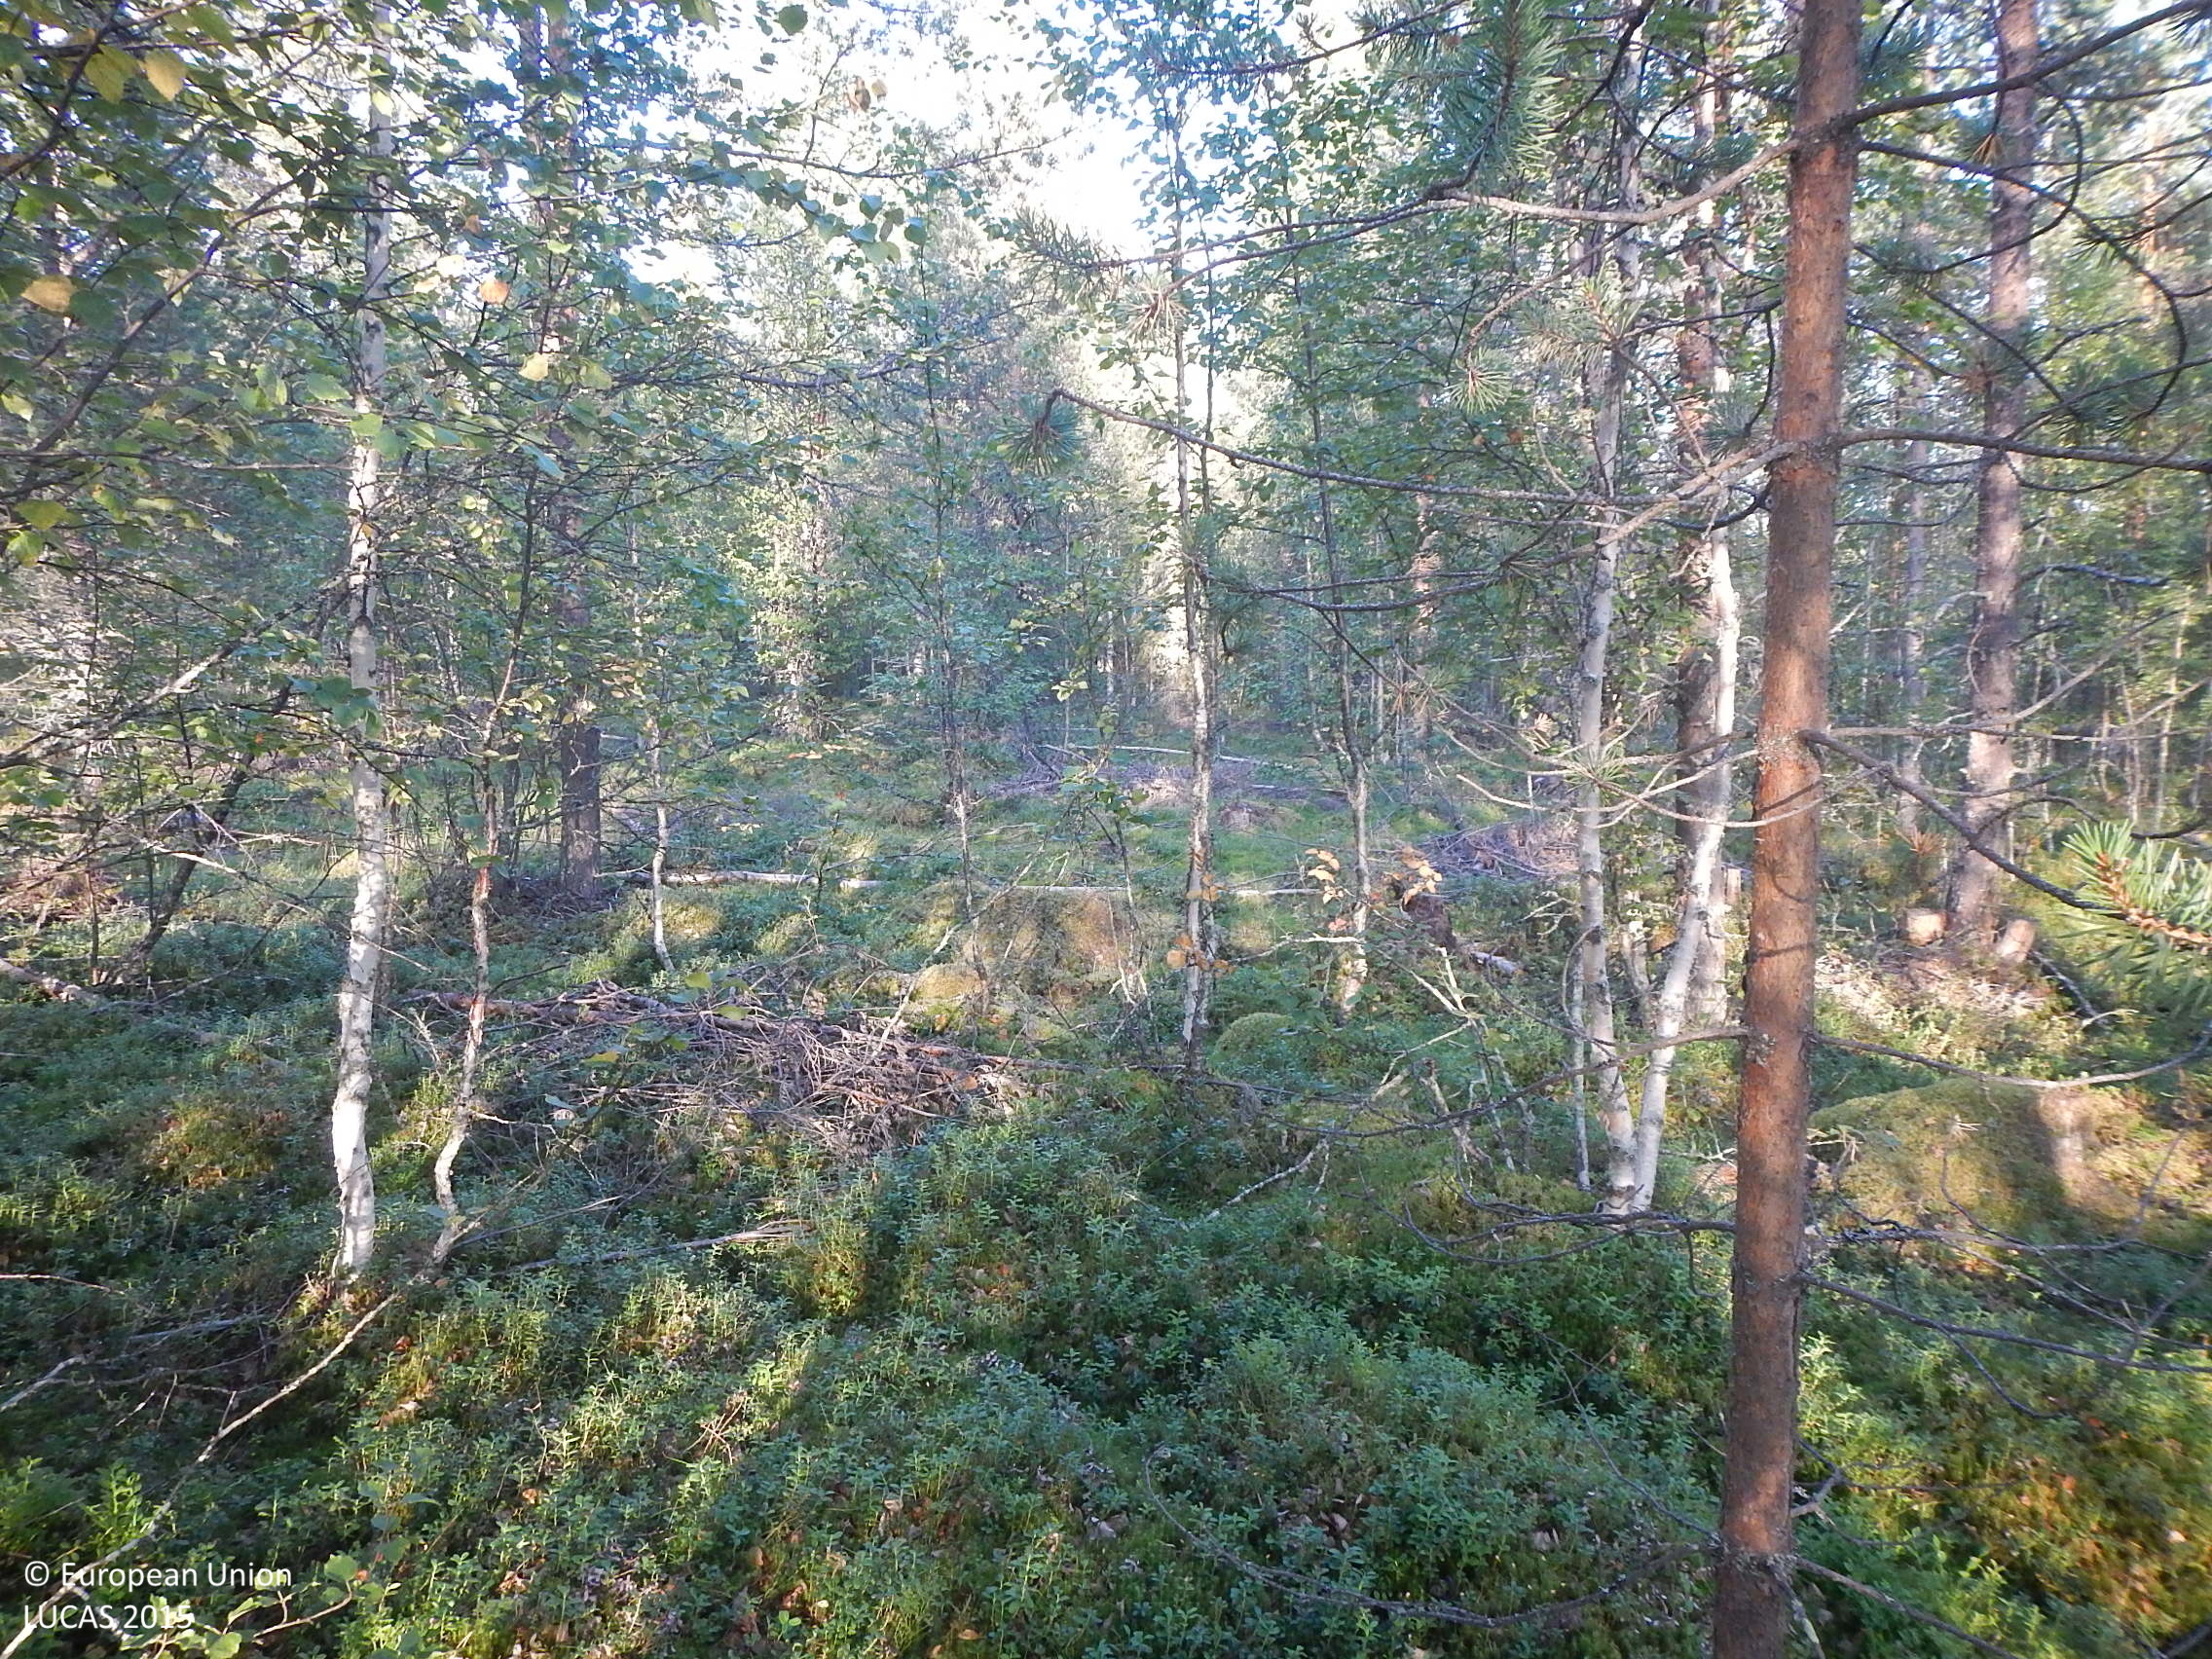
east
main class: Woodland
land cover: Pine dominated mixed woodland
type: boreal forest
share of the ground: > 75 %
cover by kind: coniferous forest trees 50 %, broadleaved forest trees 30 %, shrubs 10 %, lichens and mosses 10 %
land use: Forestry
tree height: > 5 m
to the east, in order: Pine dominated mixed woodland; Tracks; Pine dominated mixed woodland; Ditches and canals; Pine dominated mixed woodland; Pine dominated coniferous woodland; Ditches and canals; Fences; Other mixed woodland; Other coniferous woodland
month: August
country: FI
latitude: 66.4516
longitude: 28.1930
